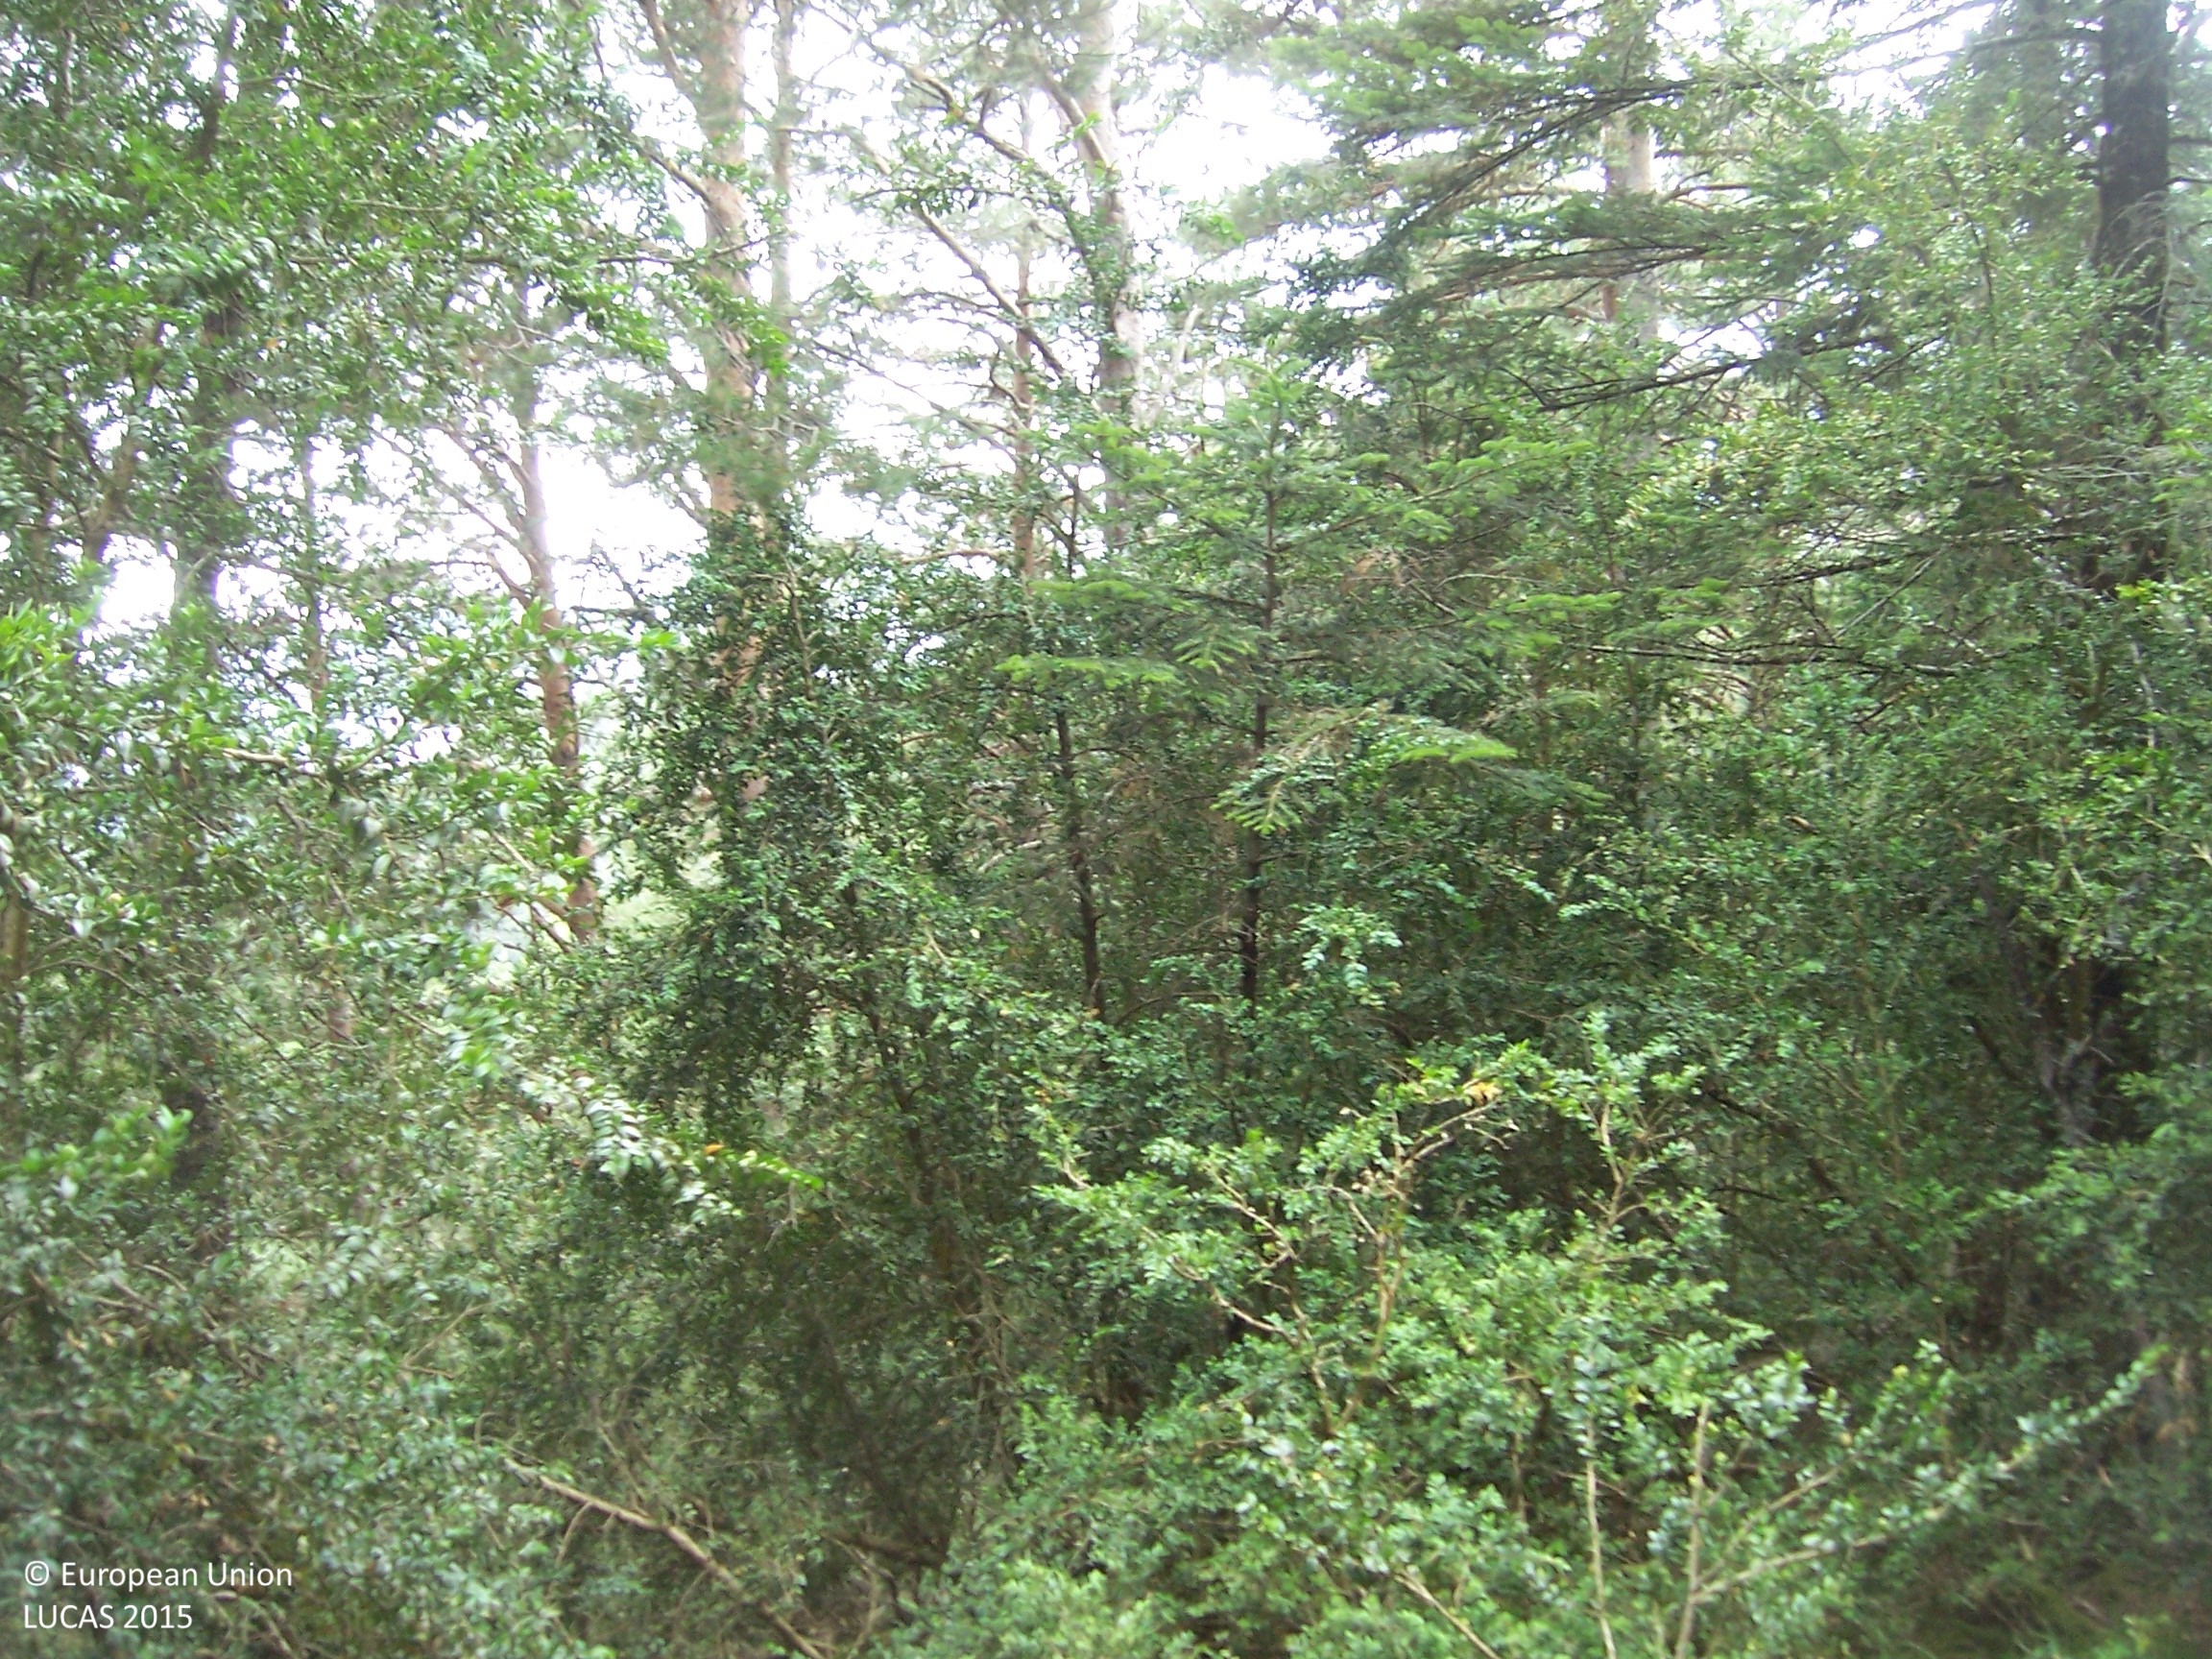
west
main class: Woodland
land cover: Pine dominated coniferous woodland
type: alpine coniferous forest
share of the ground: > 75 %
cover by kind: coniferous forest trees 80 %, shrubs 20 %
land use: Forestry
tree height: > 5 m
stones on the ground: < 10 %
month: August
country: ES
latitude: 42.6878
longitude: -0.5120
